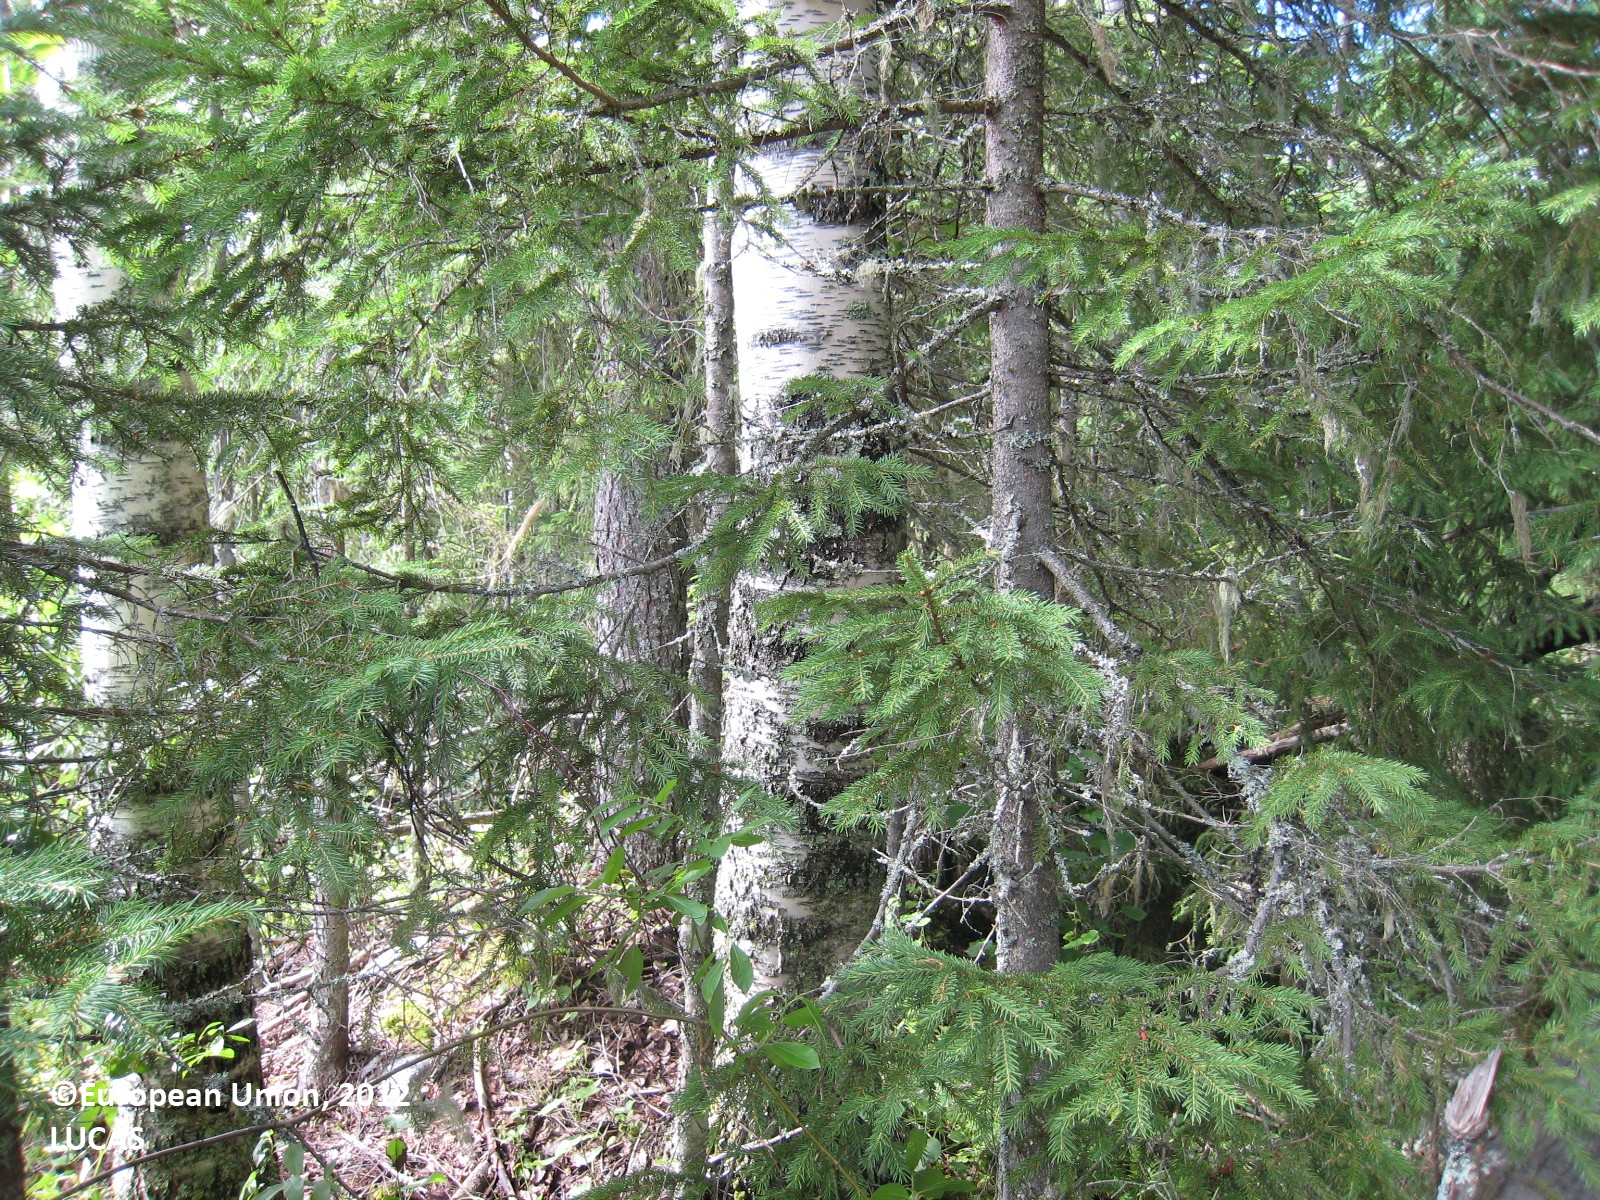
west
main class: Woodland
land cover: Other mixed woodland
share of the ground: > 75 %
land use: Semi-natural and natural areas not in use
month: July
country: FI
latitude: 63.2678
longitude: 26.8165
